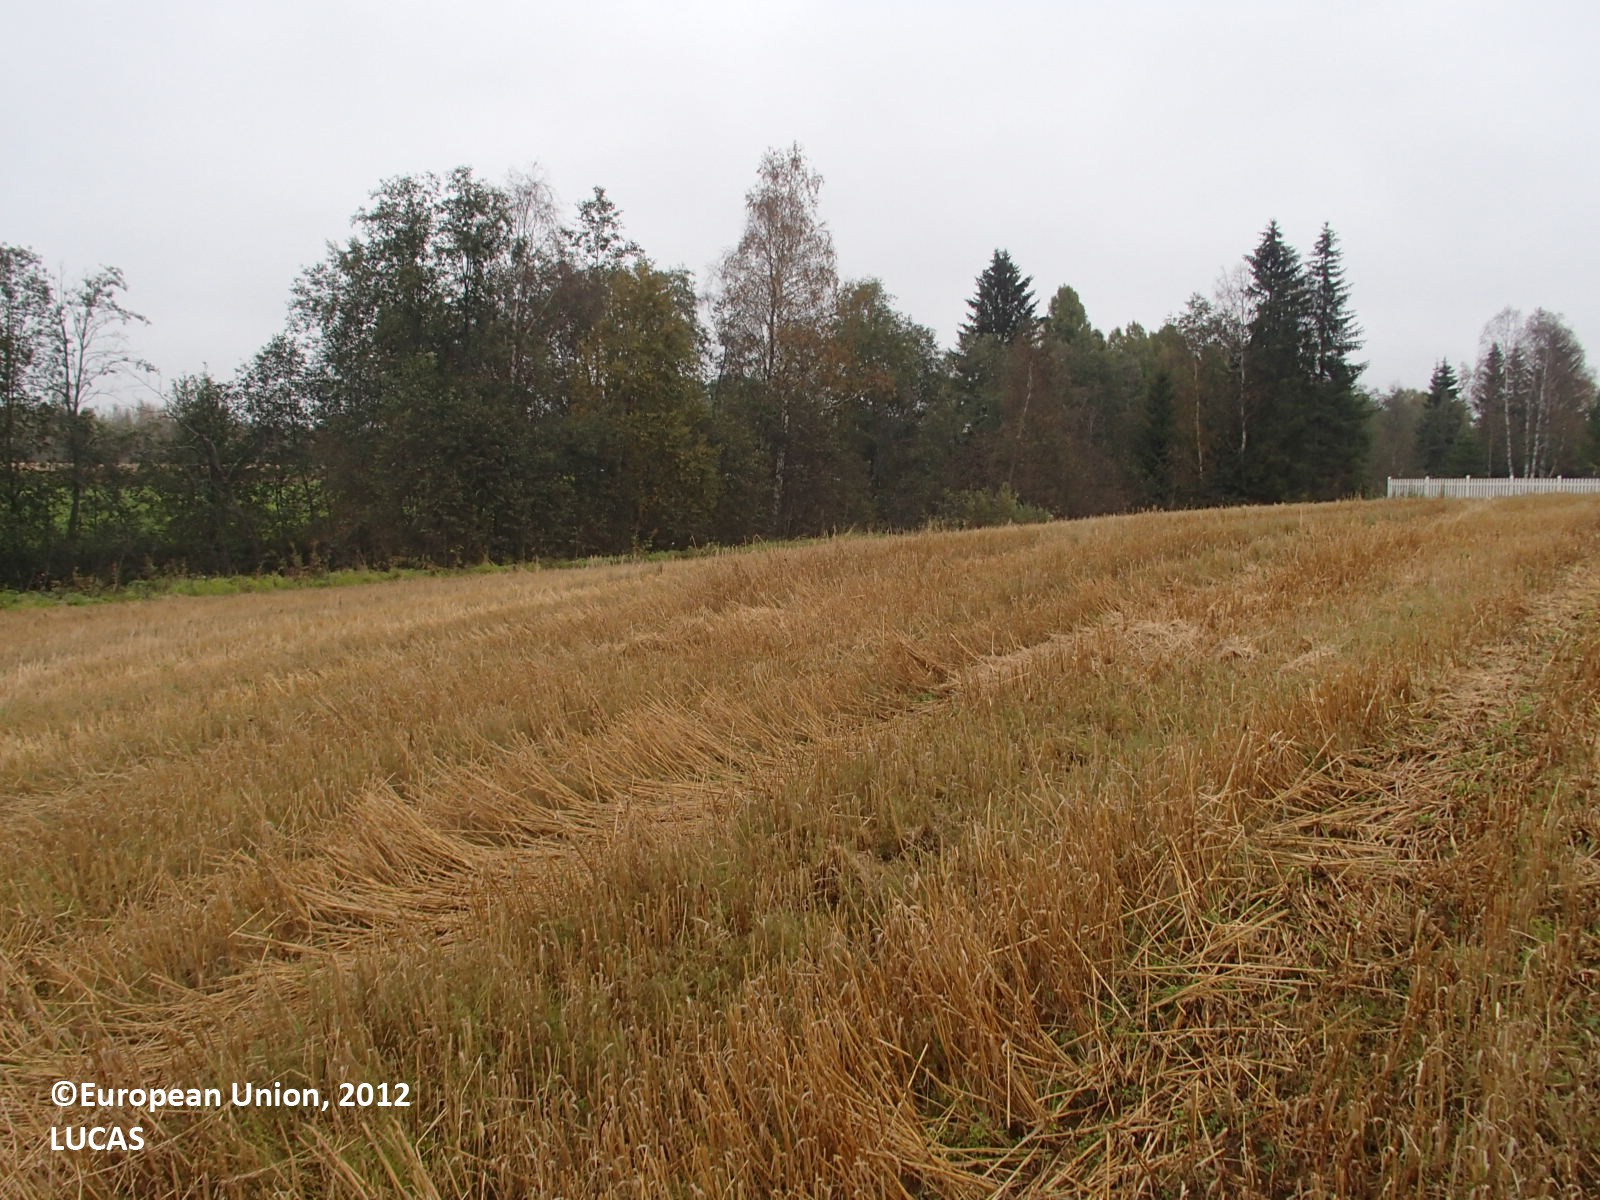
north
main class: Cropland
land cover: Barley
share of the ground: > 75 %
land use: Agriculture (excluding fallow land and kitchen gardens)
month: September
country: FI
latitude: 63.8946
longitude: 26.8549
